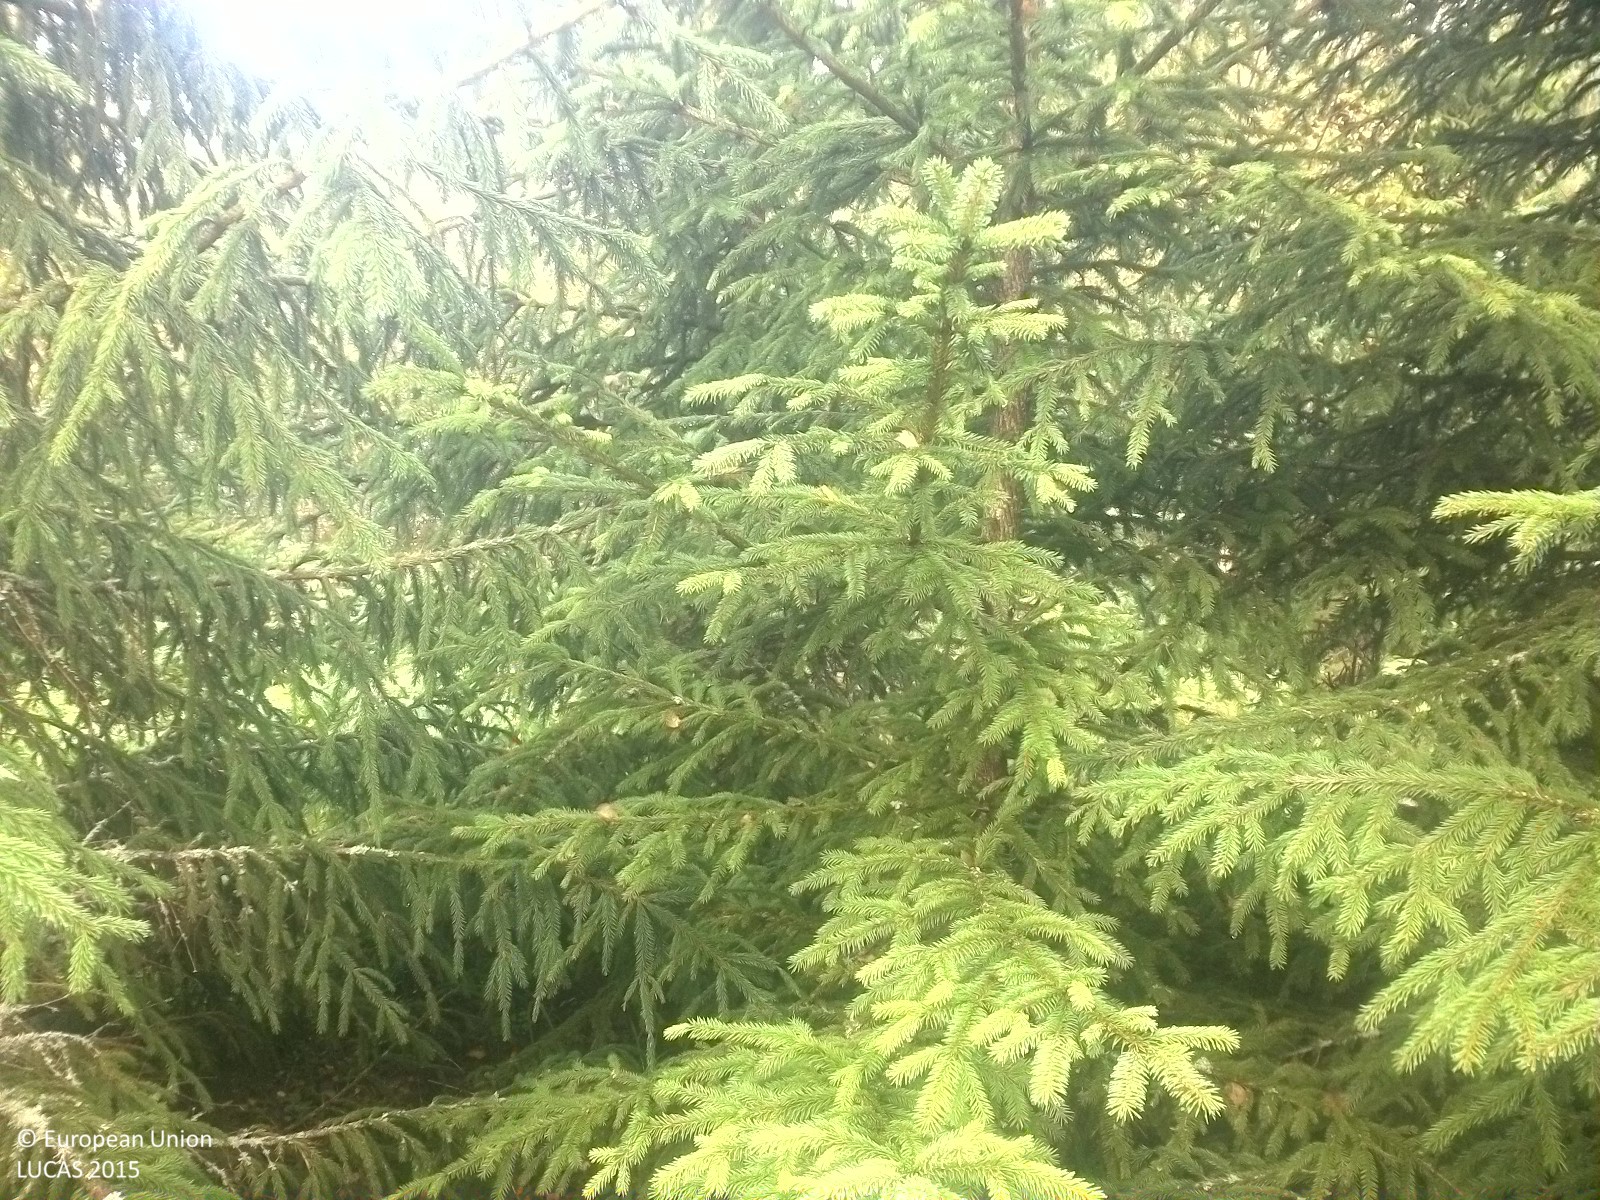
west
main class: Woodland
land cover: Other mixed woodland
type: boreal forest
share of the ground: 25 - 50 %
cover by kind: herbaceous plants 40 %, coniferous forest trees 25 %, lichens and mosses 20 %, broadleaved forest trees 15 %
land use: Forestry
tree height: < 5 m
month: September
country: SE
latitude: 59.3461
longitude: 15.6363
